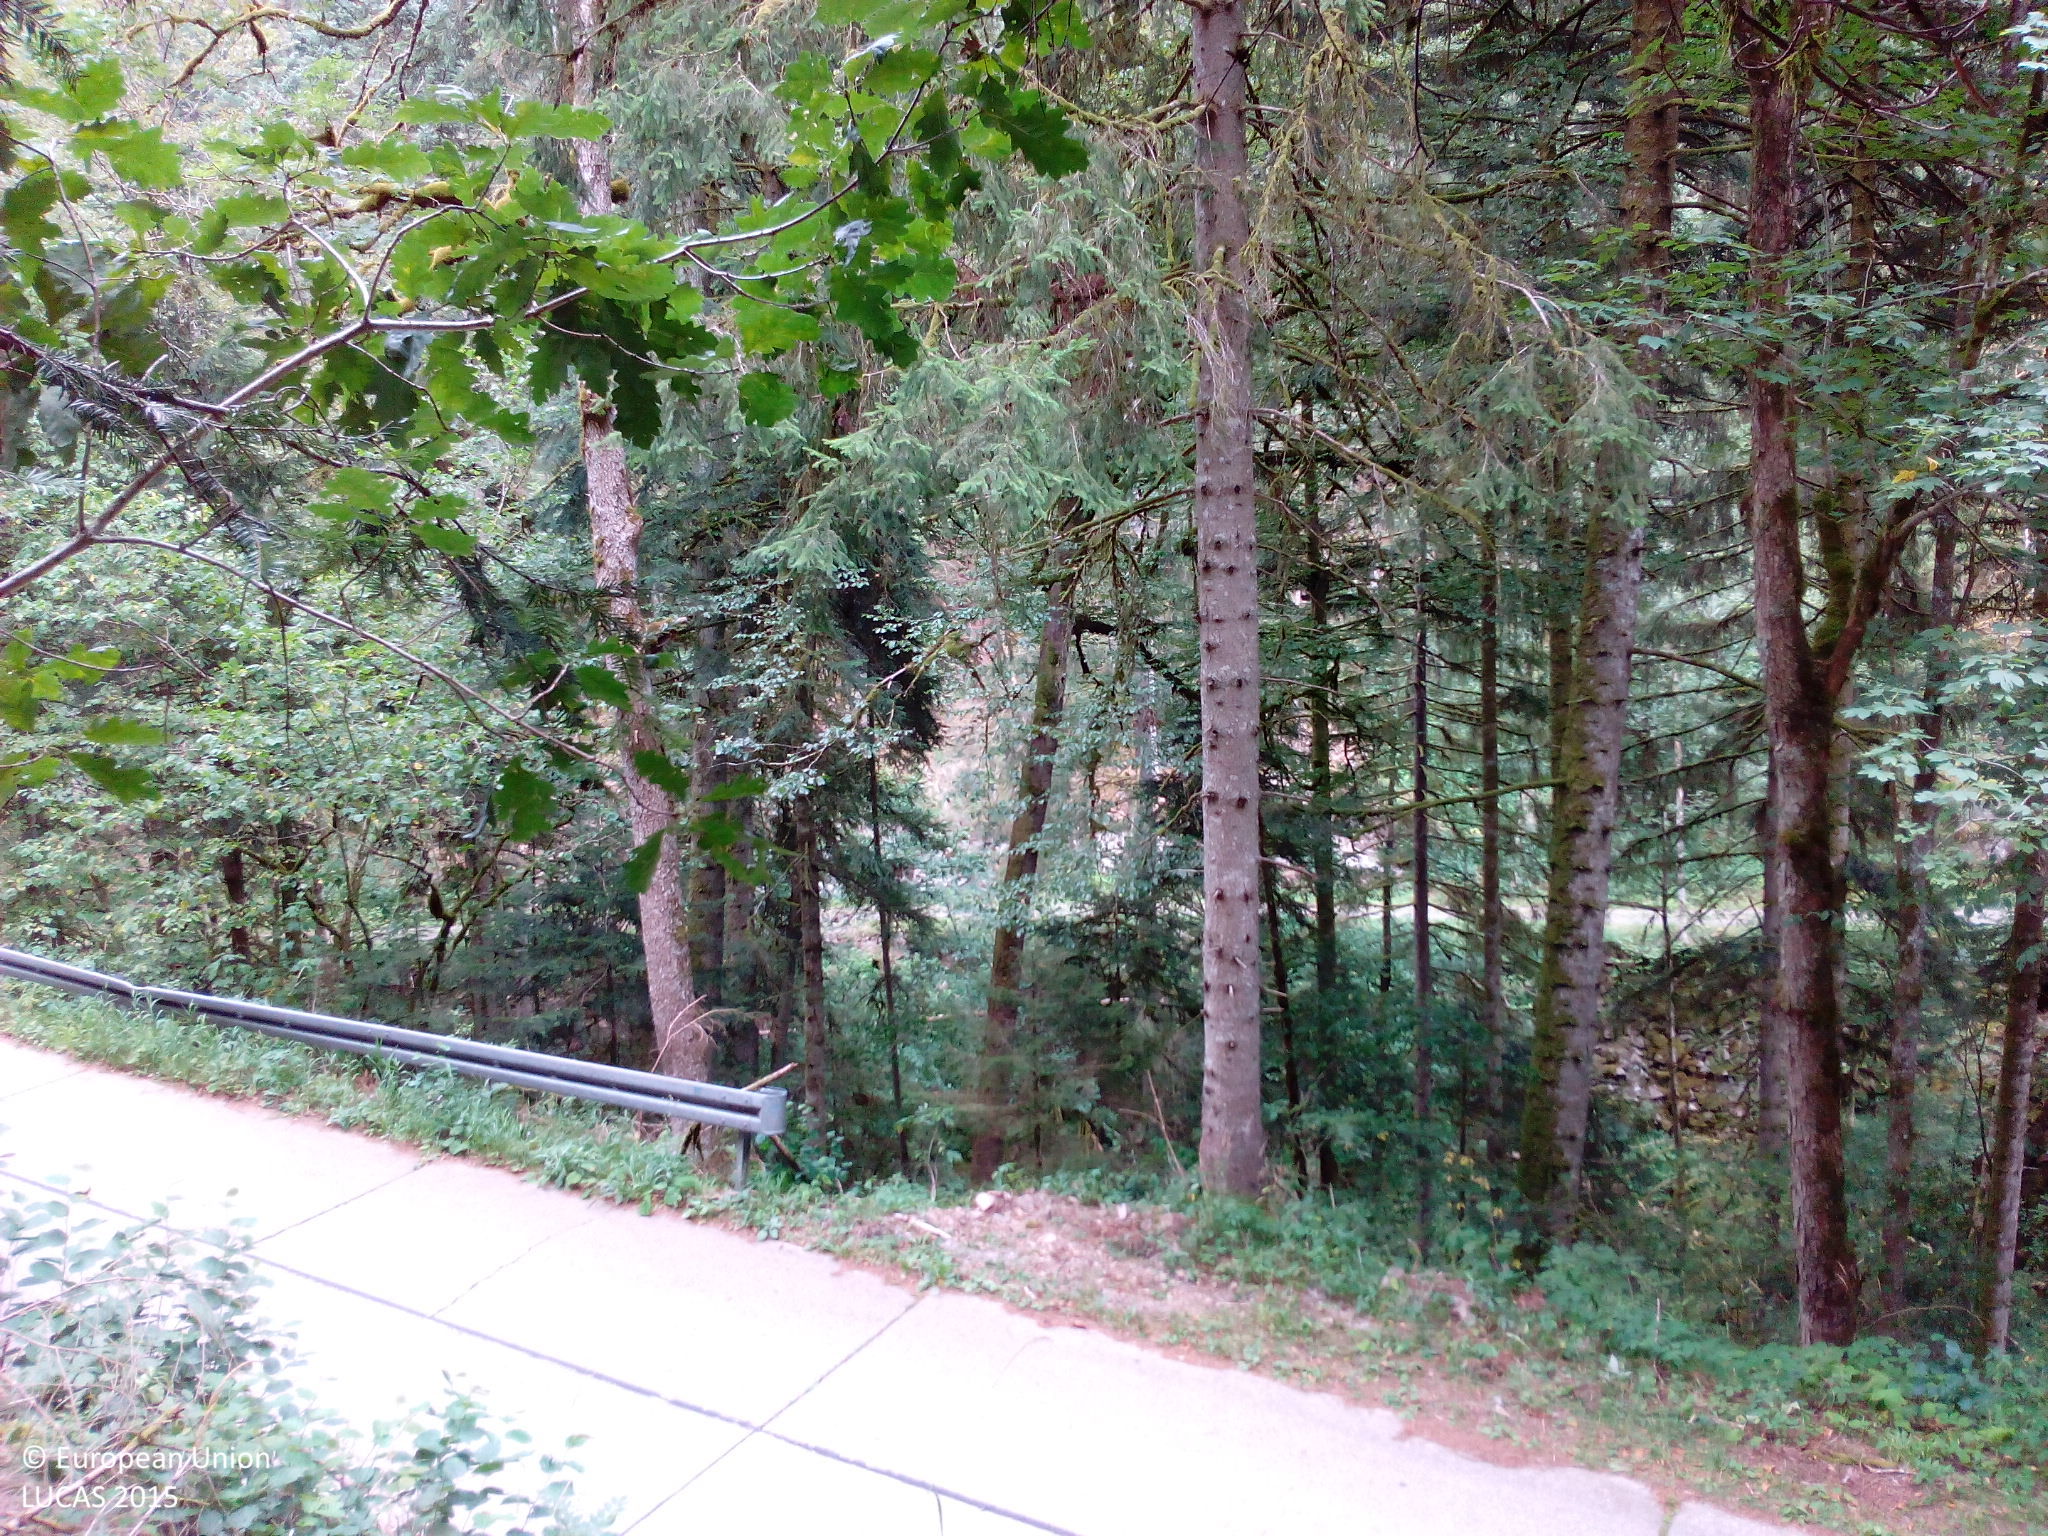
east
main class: Woodland
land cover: Spruce dominated mixed woodland
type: mesophytic deciduous forest
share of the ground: > 75 %
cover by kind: coniferous forest trees 50 %, broadleaved forest trees 25 %, lichens and mosses 10 %, shrubs 5 %, herbaceous plants 5 %, unconsolidated bare surface 5 %
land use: Forestry
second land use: Amenities, museums, leisure
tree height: > 5 m
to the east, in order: Spruce dominated mixed woodland; Ditches and canals; Paved roads, cycling and walking lanes; Spruce dominated mixed woodland; Rivers and streams; Spruce dominated coniferous woodland; Tracks; Spruce dominated mixed woodland; Tracks; Spruce dominated mixed woodland
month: August
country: DE
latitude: 47.7408
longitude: 8.2009
